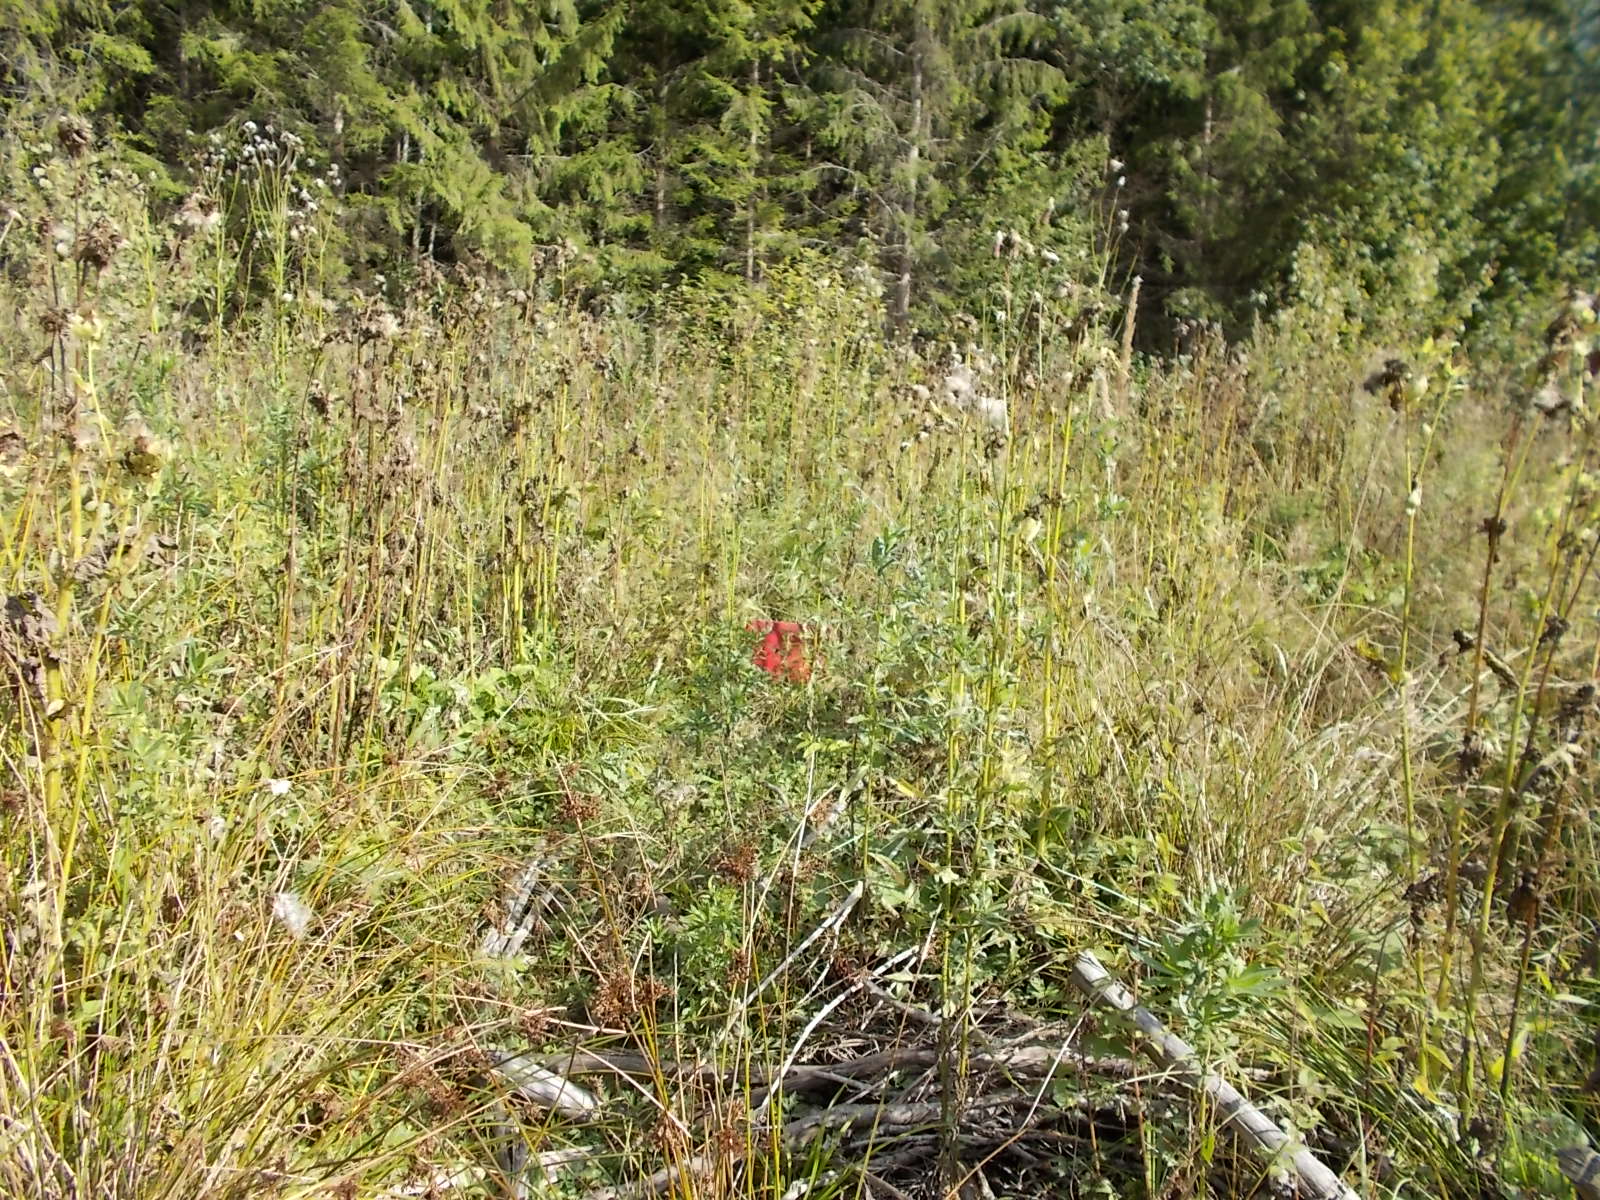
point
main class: Shrubland
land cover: Shrubland with sparse tree cover
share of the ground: > 75 %
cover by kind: shrubs 75 %, herbaceous plants 20 %, broadleaved forest trees 5 %
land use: Forestry
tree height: < 5 m
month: September
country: LV
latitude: 56.9345
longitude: 22.9303
